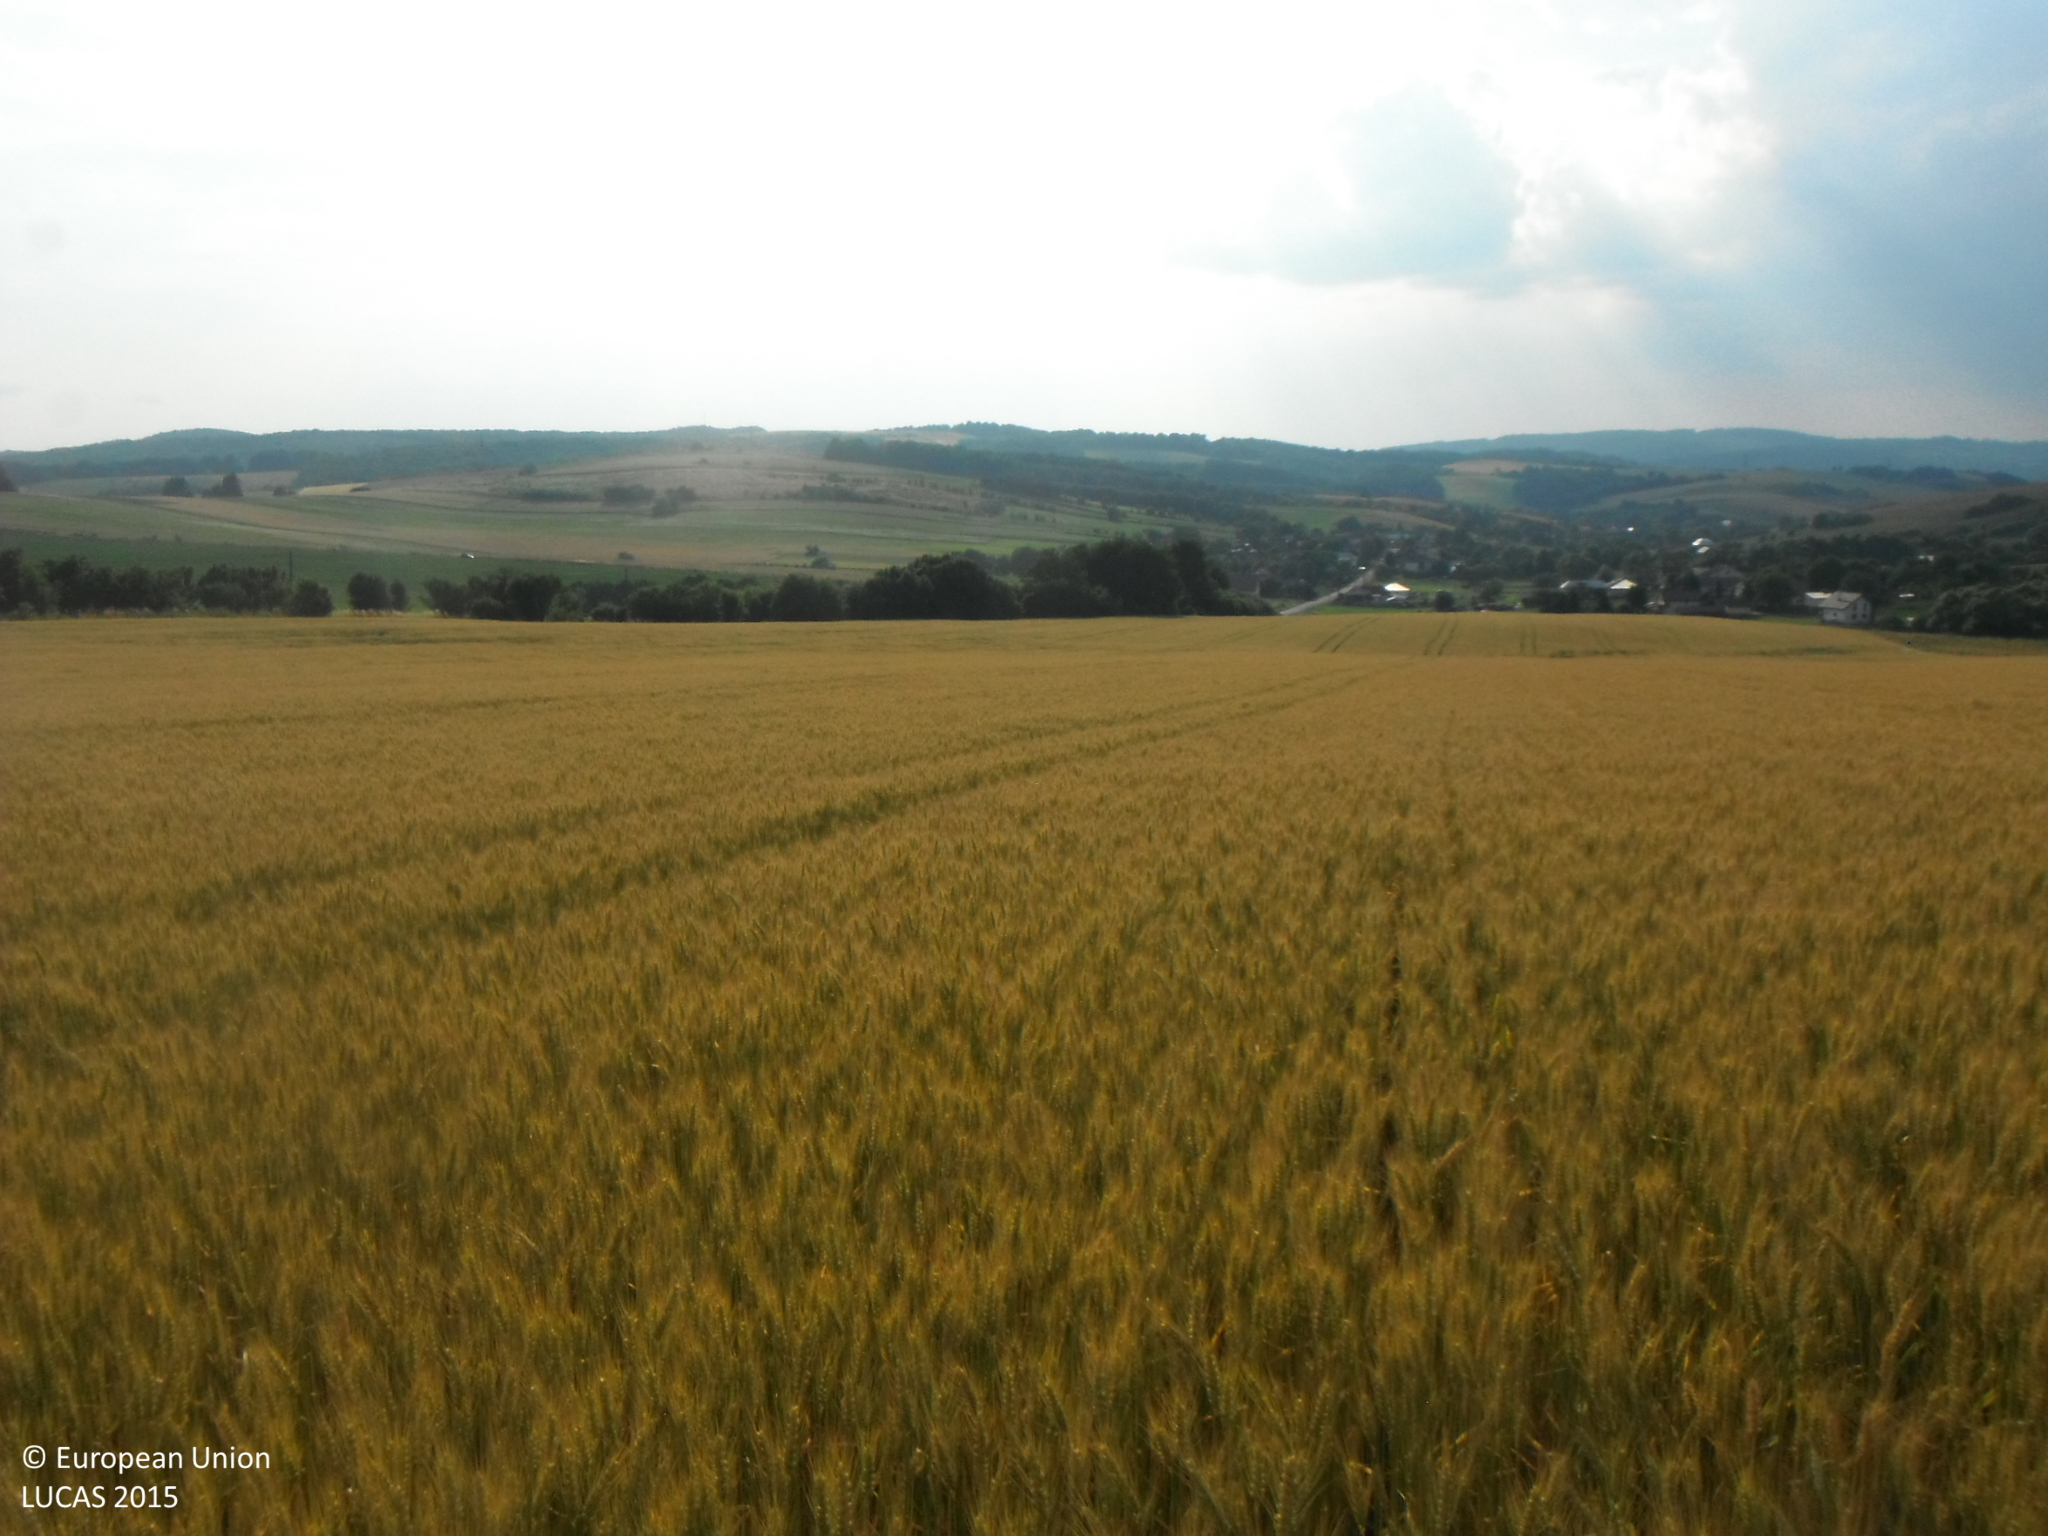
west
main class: Cropland
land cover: Common wheat
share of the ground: > 75 %
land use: Agriculture (excluding fallow land and kitchen gardens)
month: July
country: SK
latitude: 49.0030
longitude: 21.8225
